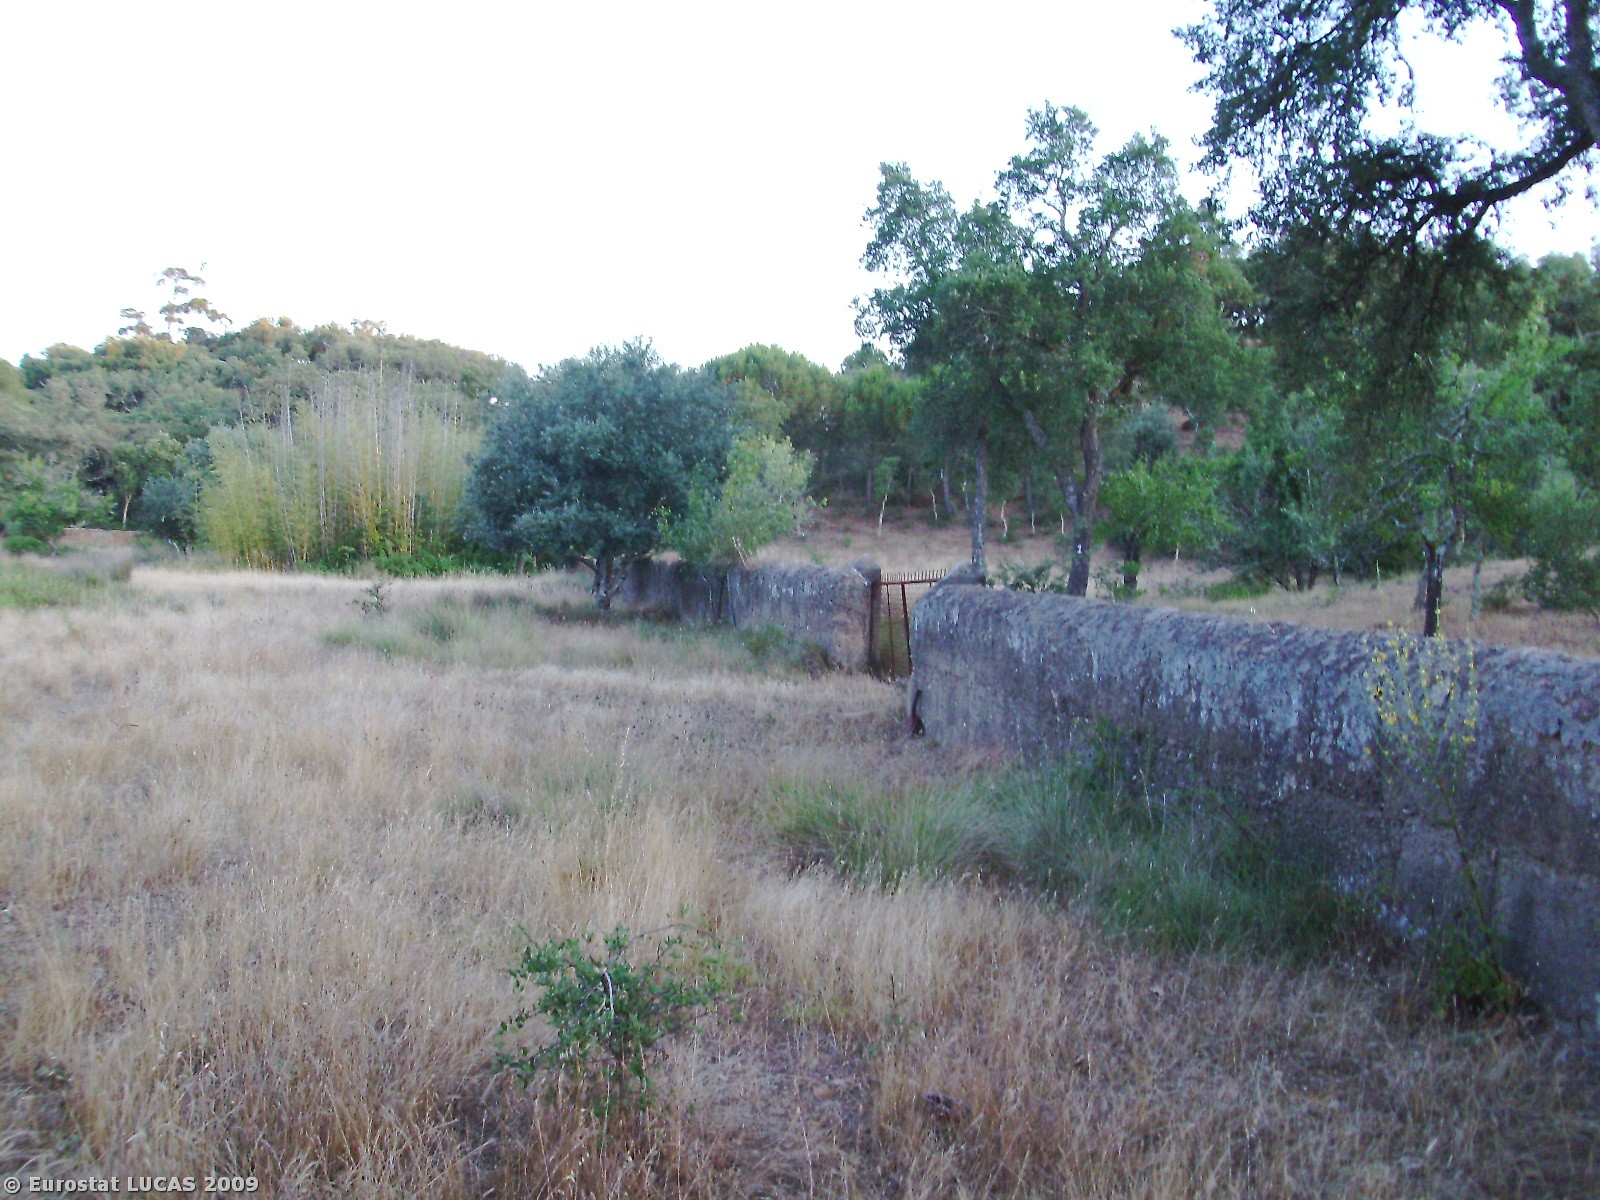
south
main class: Woodland
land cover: Broadleaved woodland
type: broadleaved evergreen forest
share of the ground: 10 - 25 %
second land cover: Grassland with sparse tree/shrub cover
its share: 50 - 75 %
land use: Forestry
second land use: Agriculture (excluding fallow land and kitchen gardens)
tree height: > 5 m
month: June
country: PT
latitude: 38.0959
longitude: -8.5297
